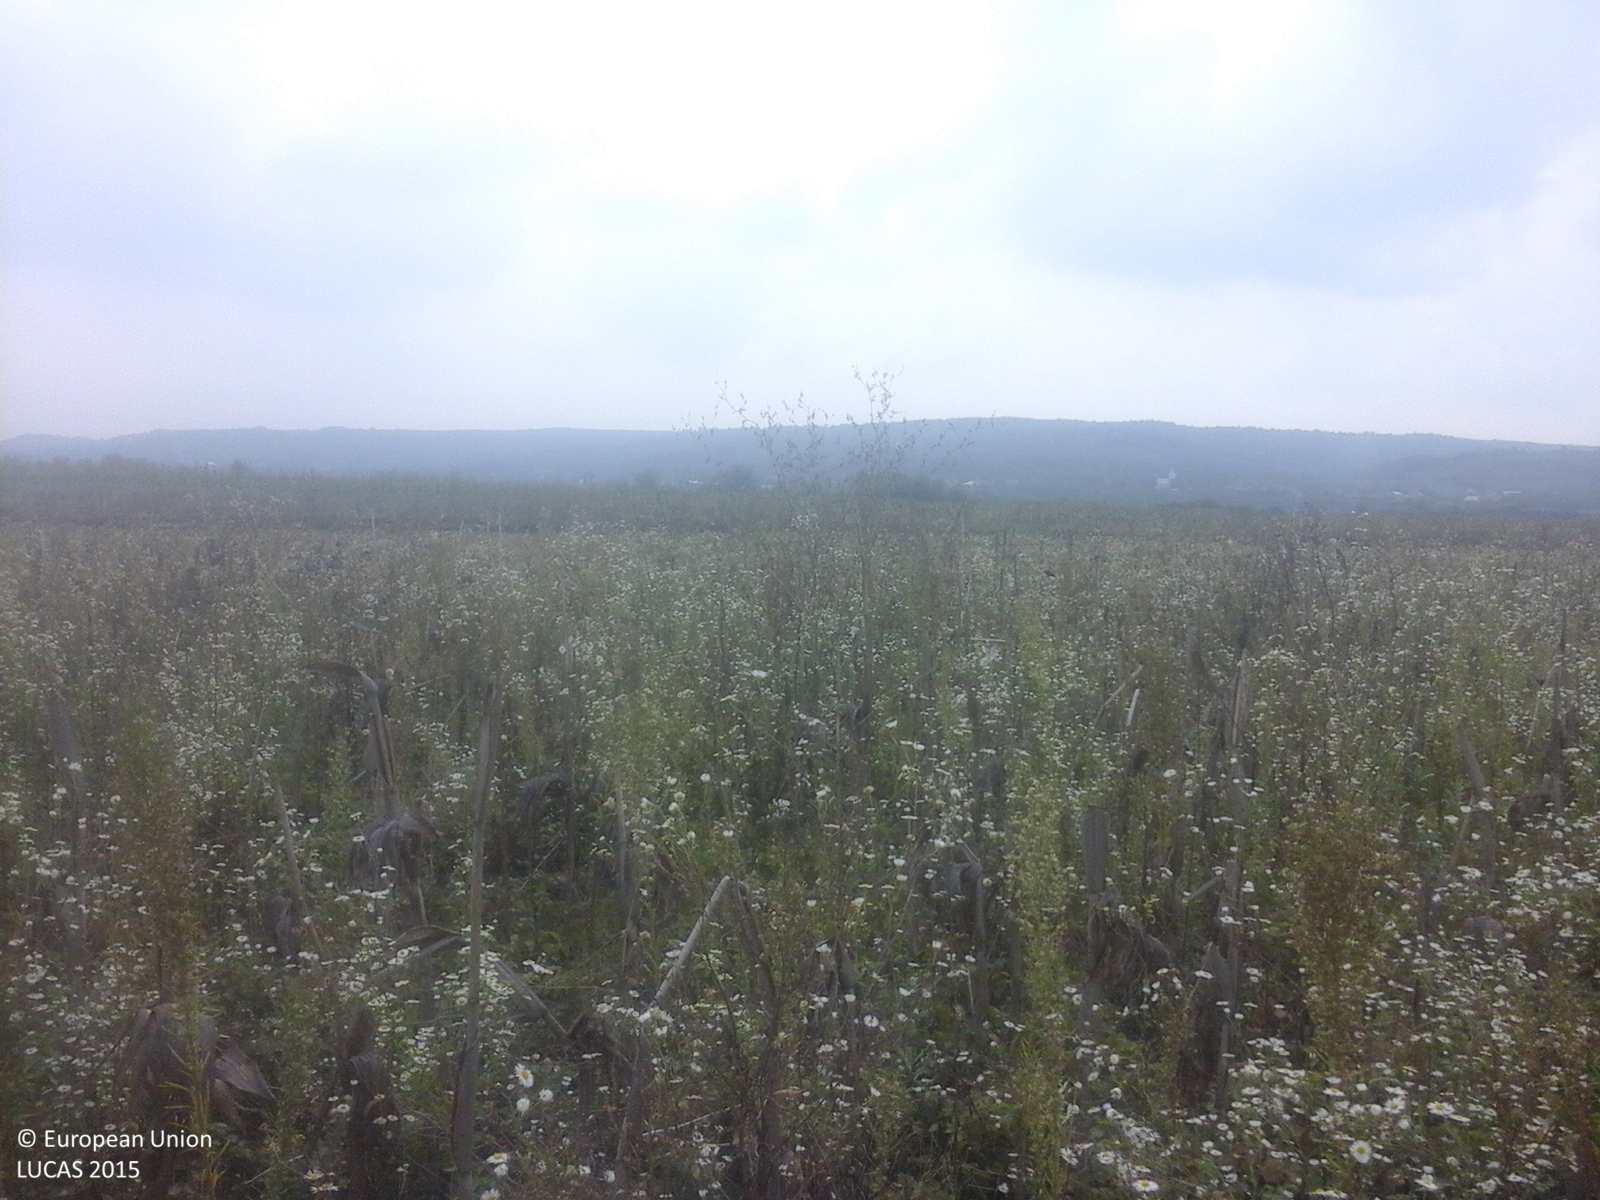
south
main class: Cropland
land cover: Maize
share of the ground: 50 - 75 %
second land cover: Spontaneously vegetated surfaces
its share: < 10 %
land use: Agriculture (excluding fallow land and kitchen gardens)
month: September
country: RO
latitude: 44.7431
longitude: 23.3518
